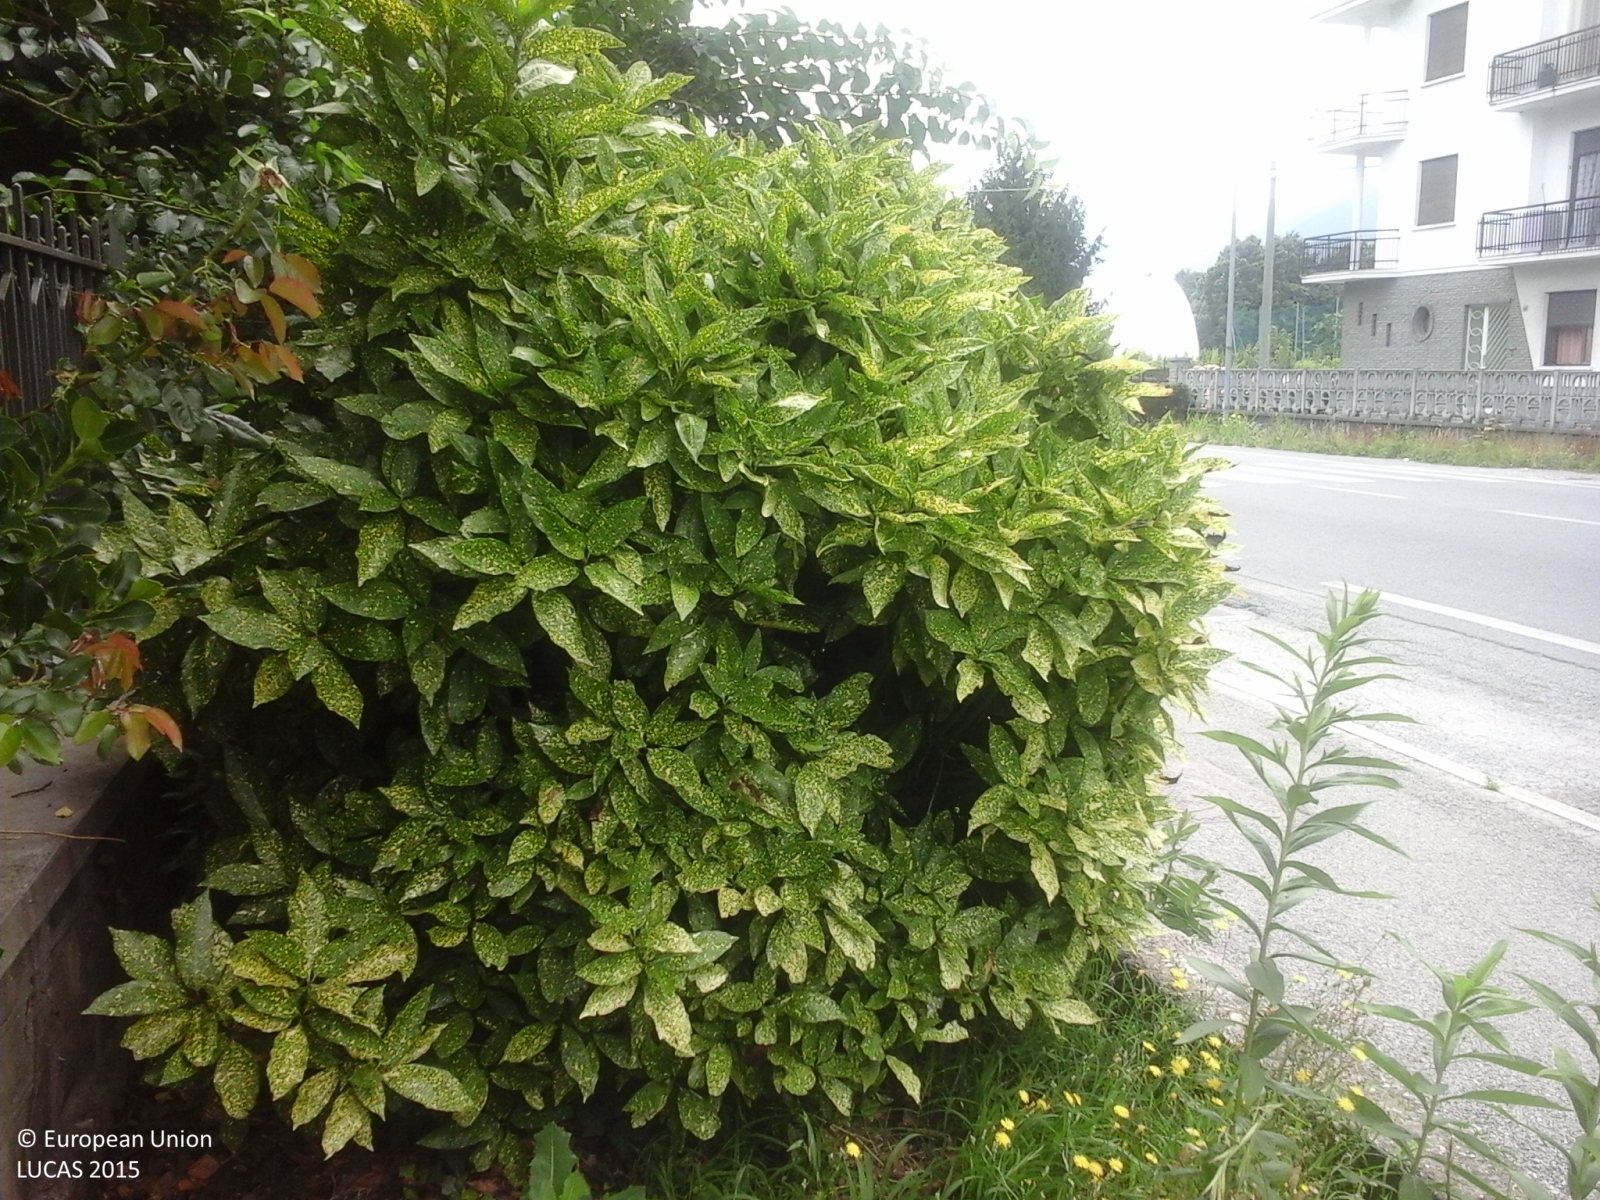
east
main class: Grassland
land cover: Grassland with sparse tree/shrub cover
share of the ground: > 75 %
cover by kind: herbaceous plants 90 %, broadleaved forest trees 5 %, shrubs 5 %
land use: Residential
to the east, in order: Artificial constructions in urban areas
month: July
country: IT
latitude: 45.1085
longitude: 7.2719
